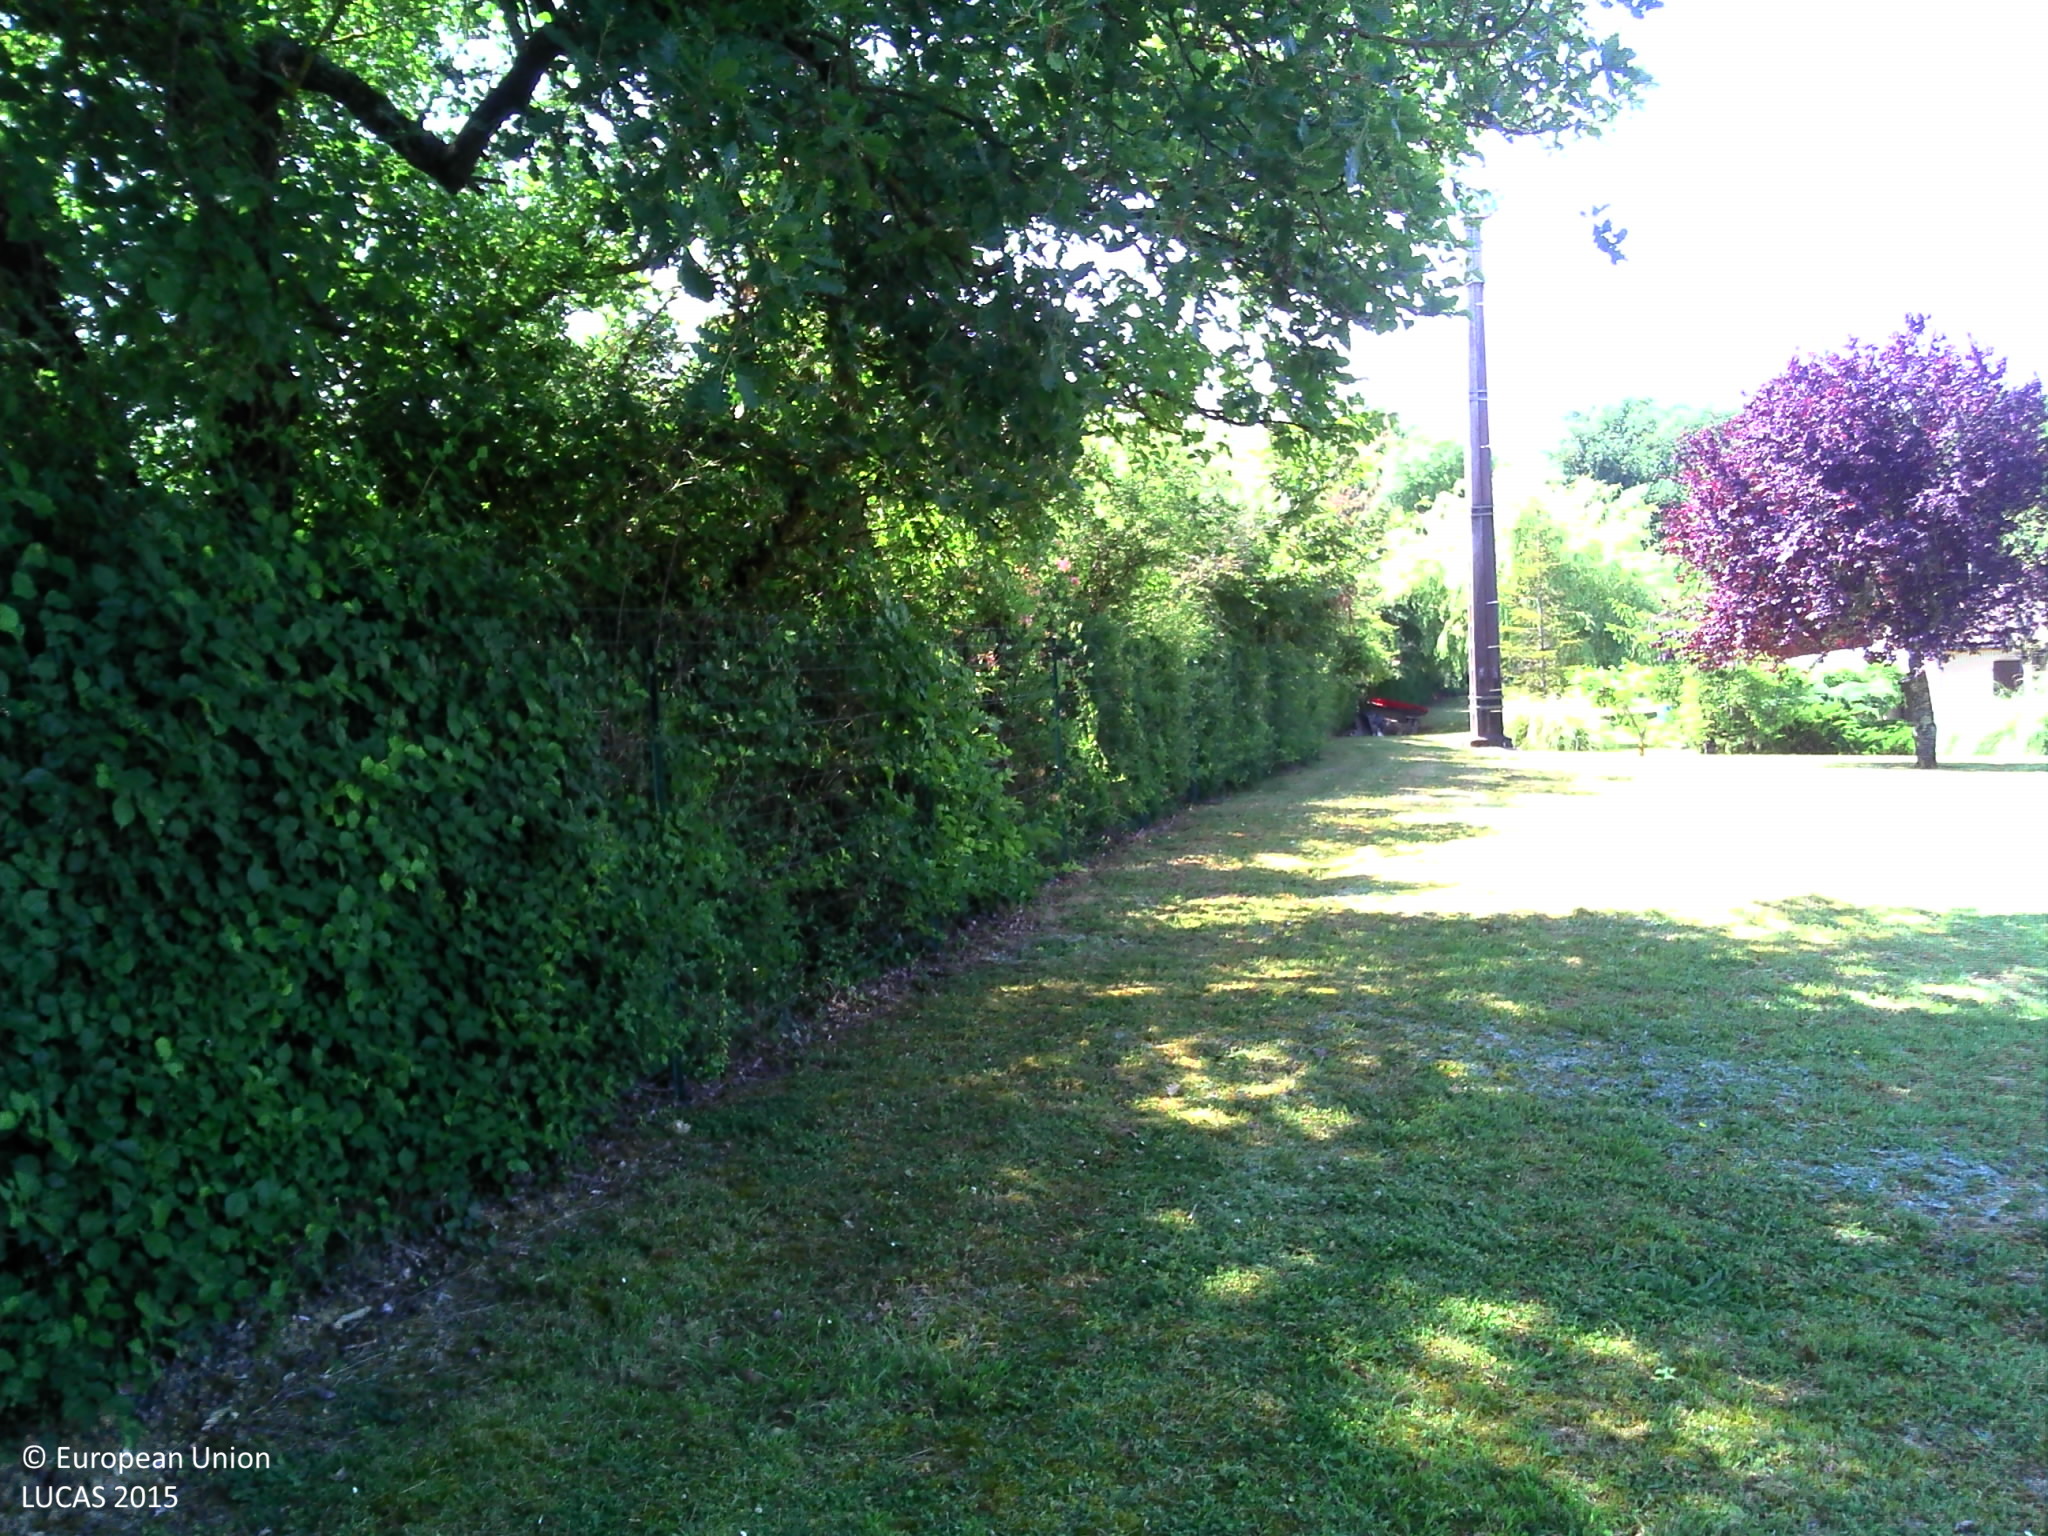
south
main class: Grassland
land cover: Grassland with sparse tree/shrub cover
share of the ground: > 75 %
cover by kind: herbaceous plants 95 %, broadleaved forest trees 5 %
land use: Residential
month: June
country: FR
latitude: 43.6586
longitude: 0.6858
